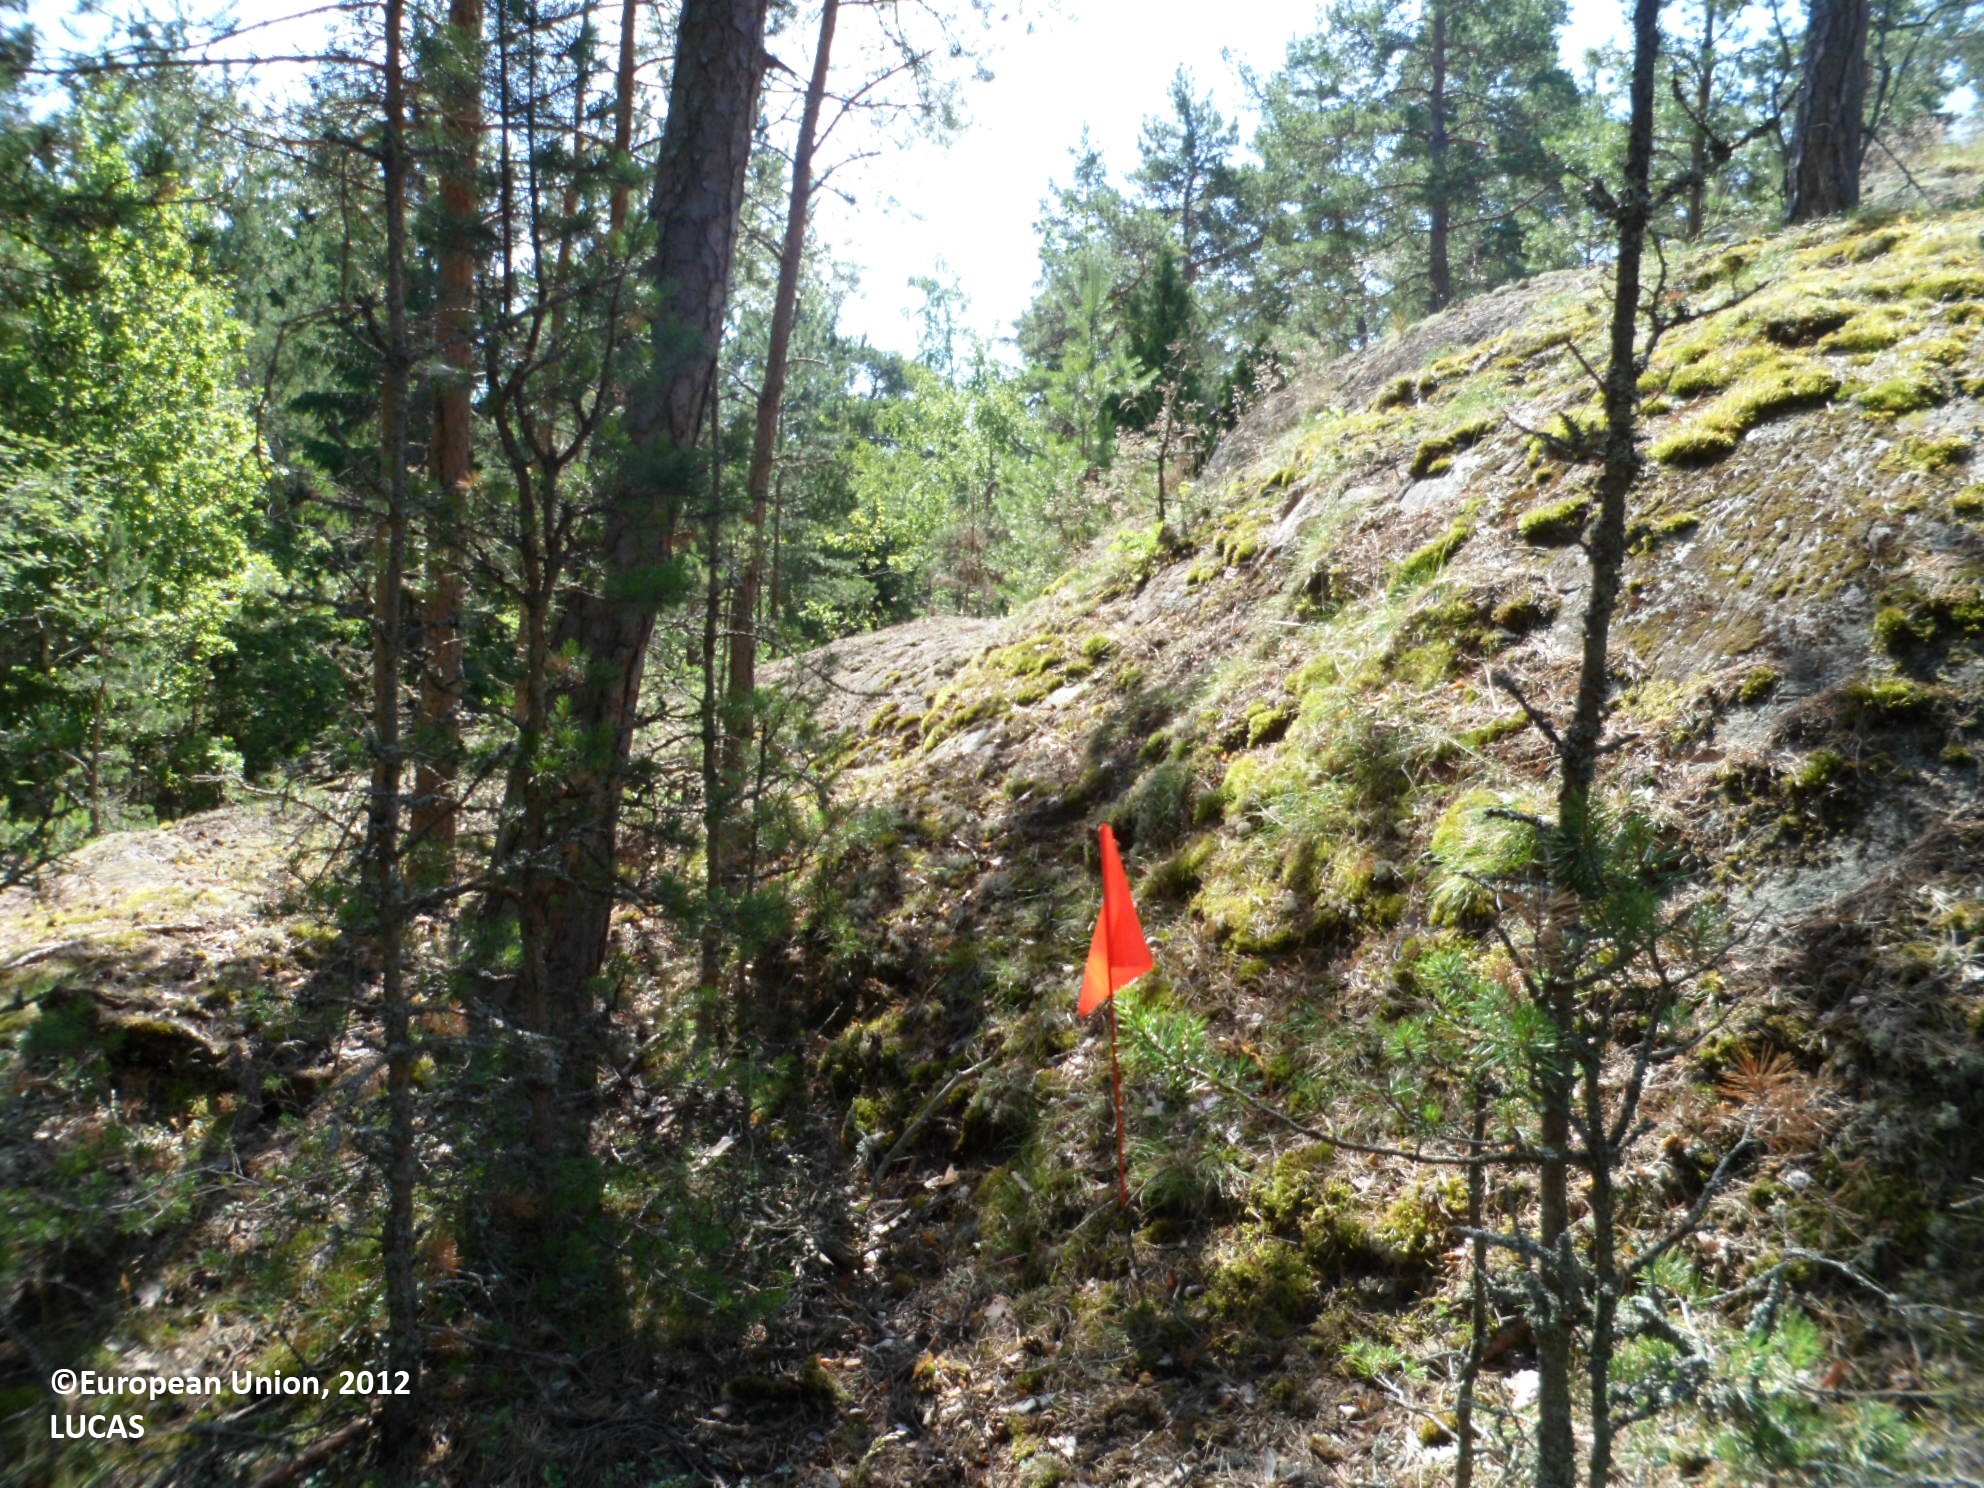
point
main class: Woodland
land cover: Pine dominated coniferous woodland
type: boreal forest
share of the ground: 50 - 75 %
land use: Forestry
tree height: > 5 m
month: July
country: SE
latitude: 59.3781
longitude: 18.5373
